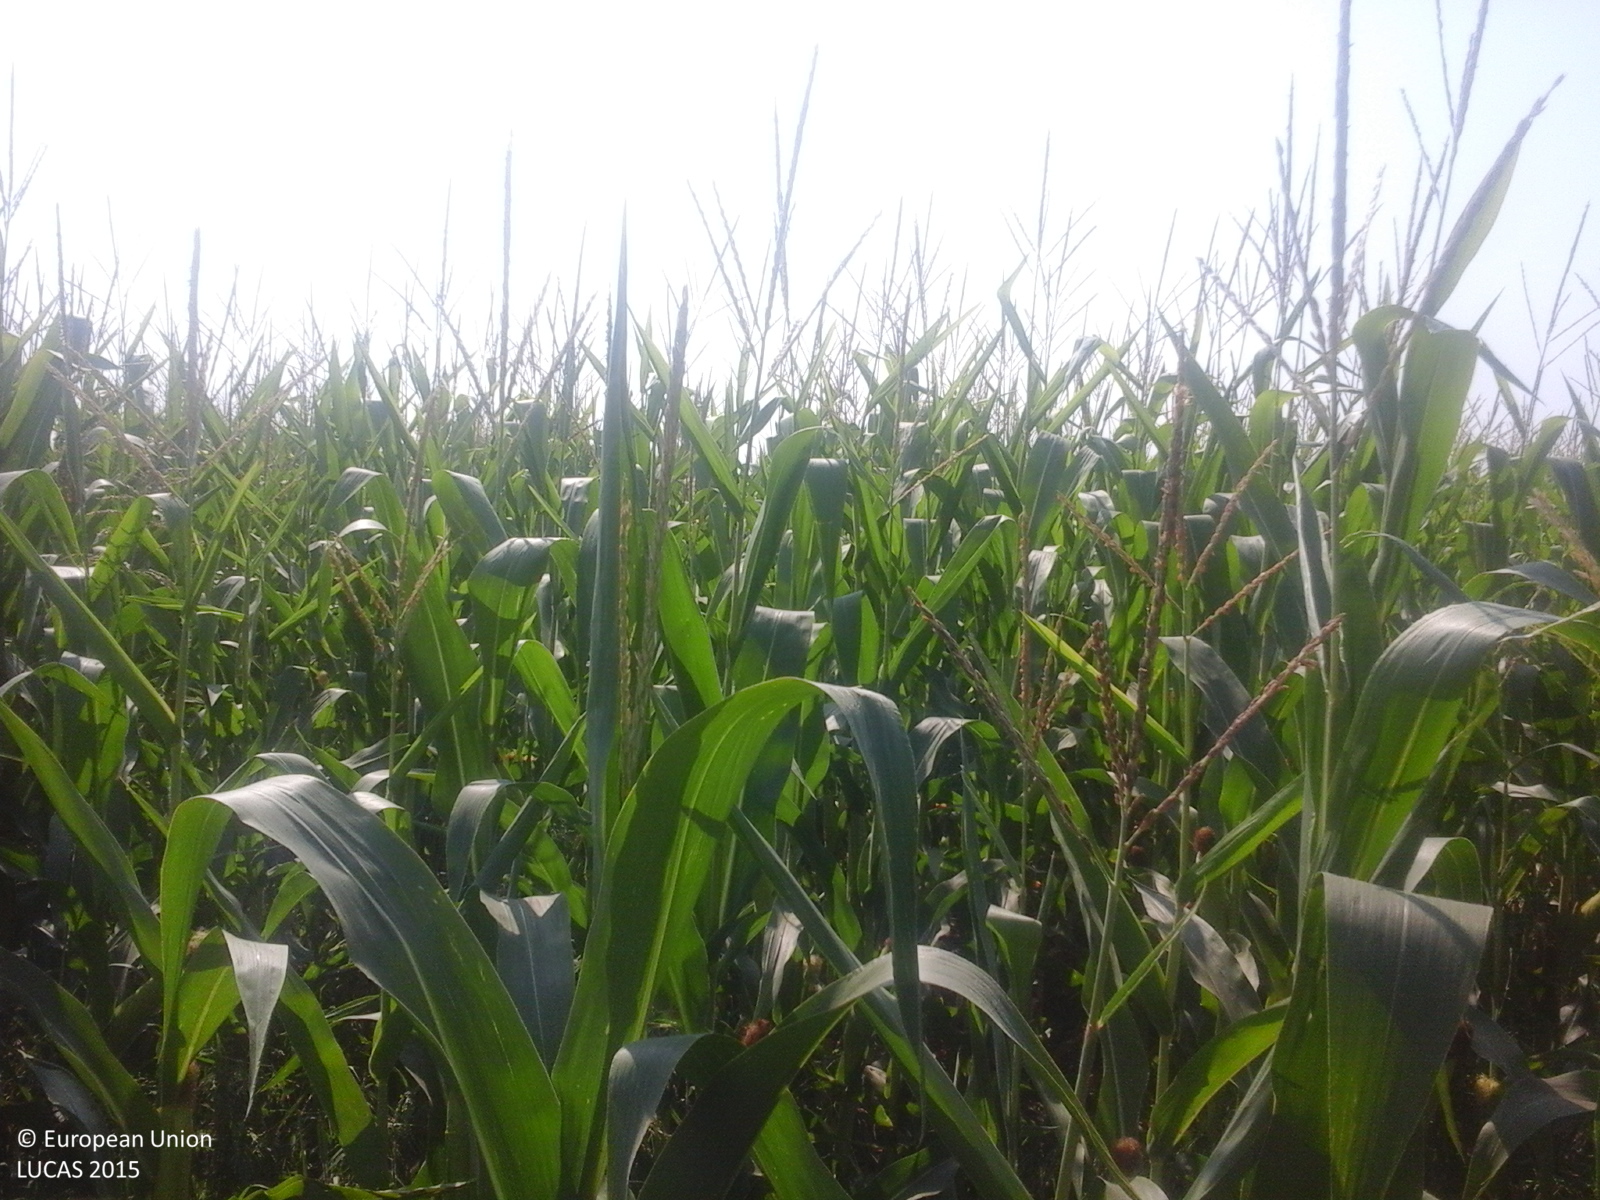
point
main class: Cropland
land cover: Maize
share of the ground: > 75 %
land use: Agriculture (excluding fallow land and kitchen gardens)
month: July
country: RO
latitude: 44.9380
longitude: 26.7918
